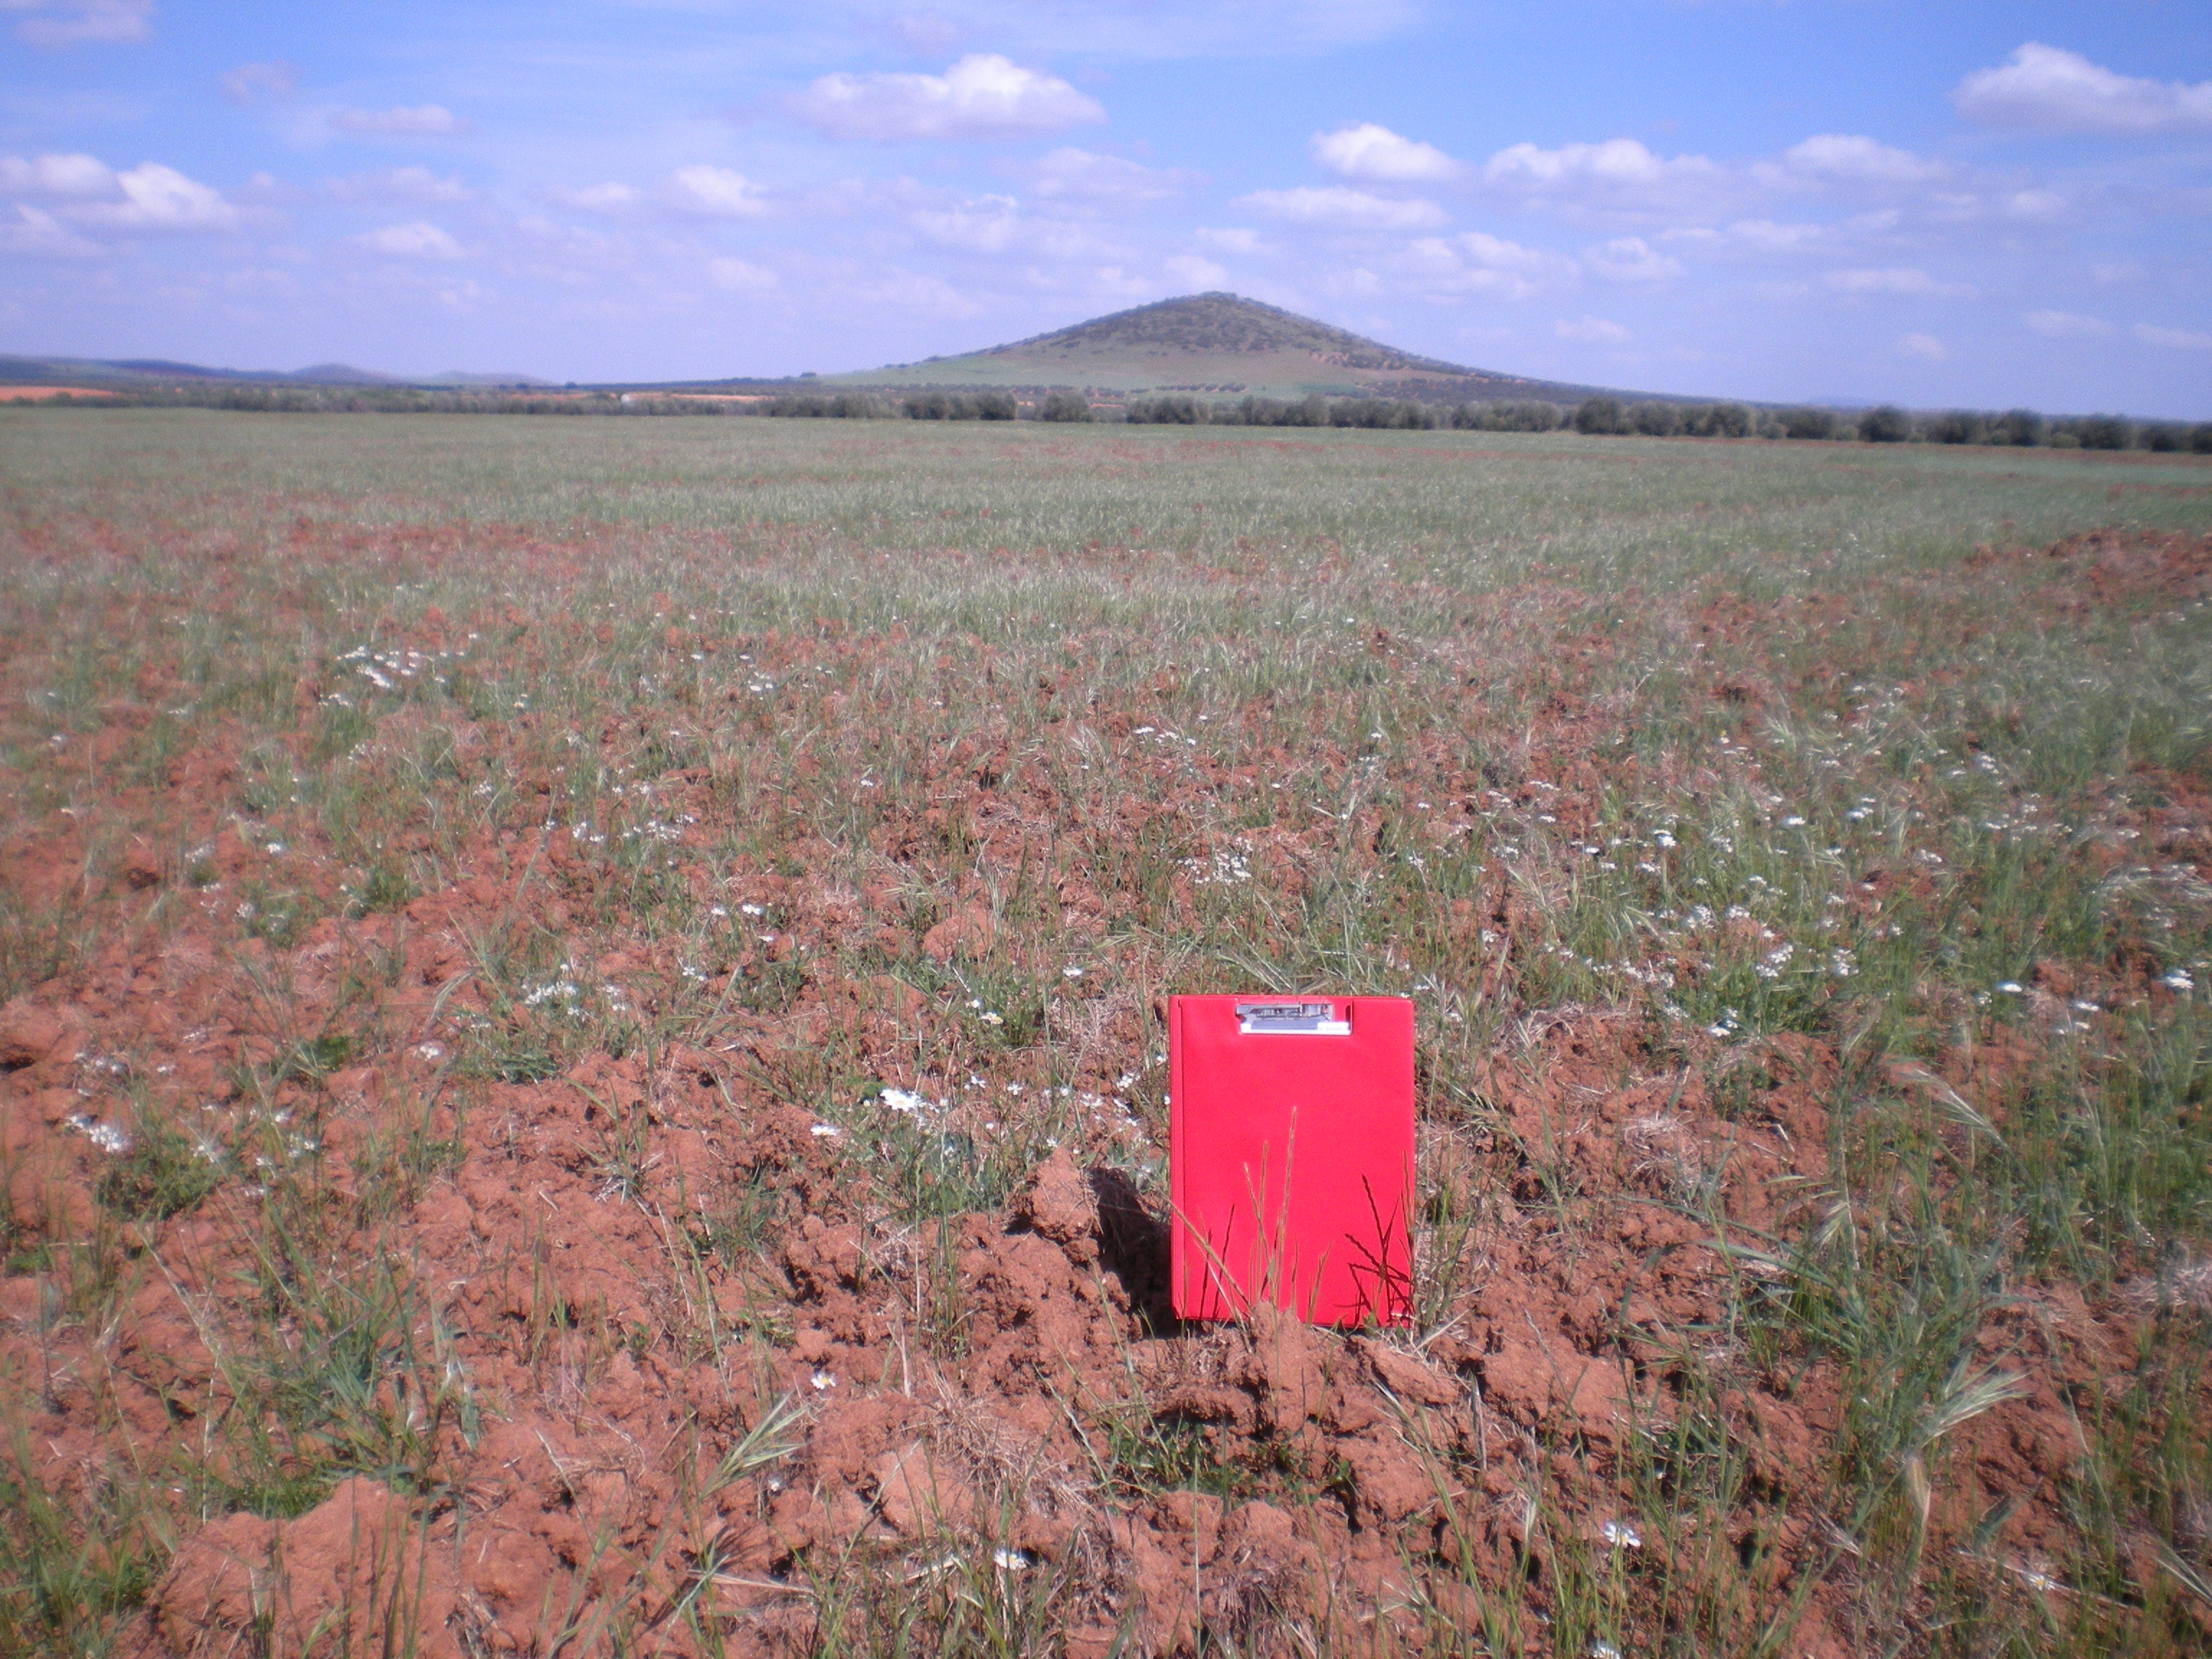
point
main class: Grassland
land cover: Spontaneously vegetated surfaces
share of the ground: 25 - 50 %
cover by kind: unconsolidated bare surface 70 %, herbaceous plants 30 %
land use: Fallow land
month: April
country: ES
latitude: 38.6822
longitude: -3.5417
